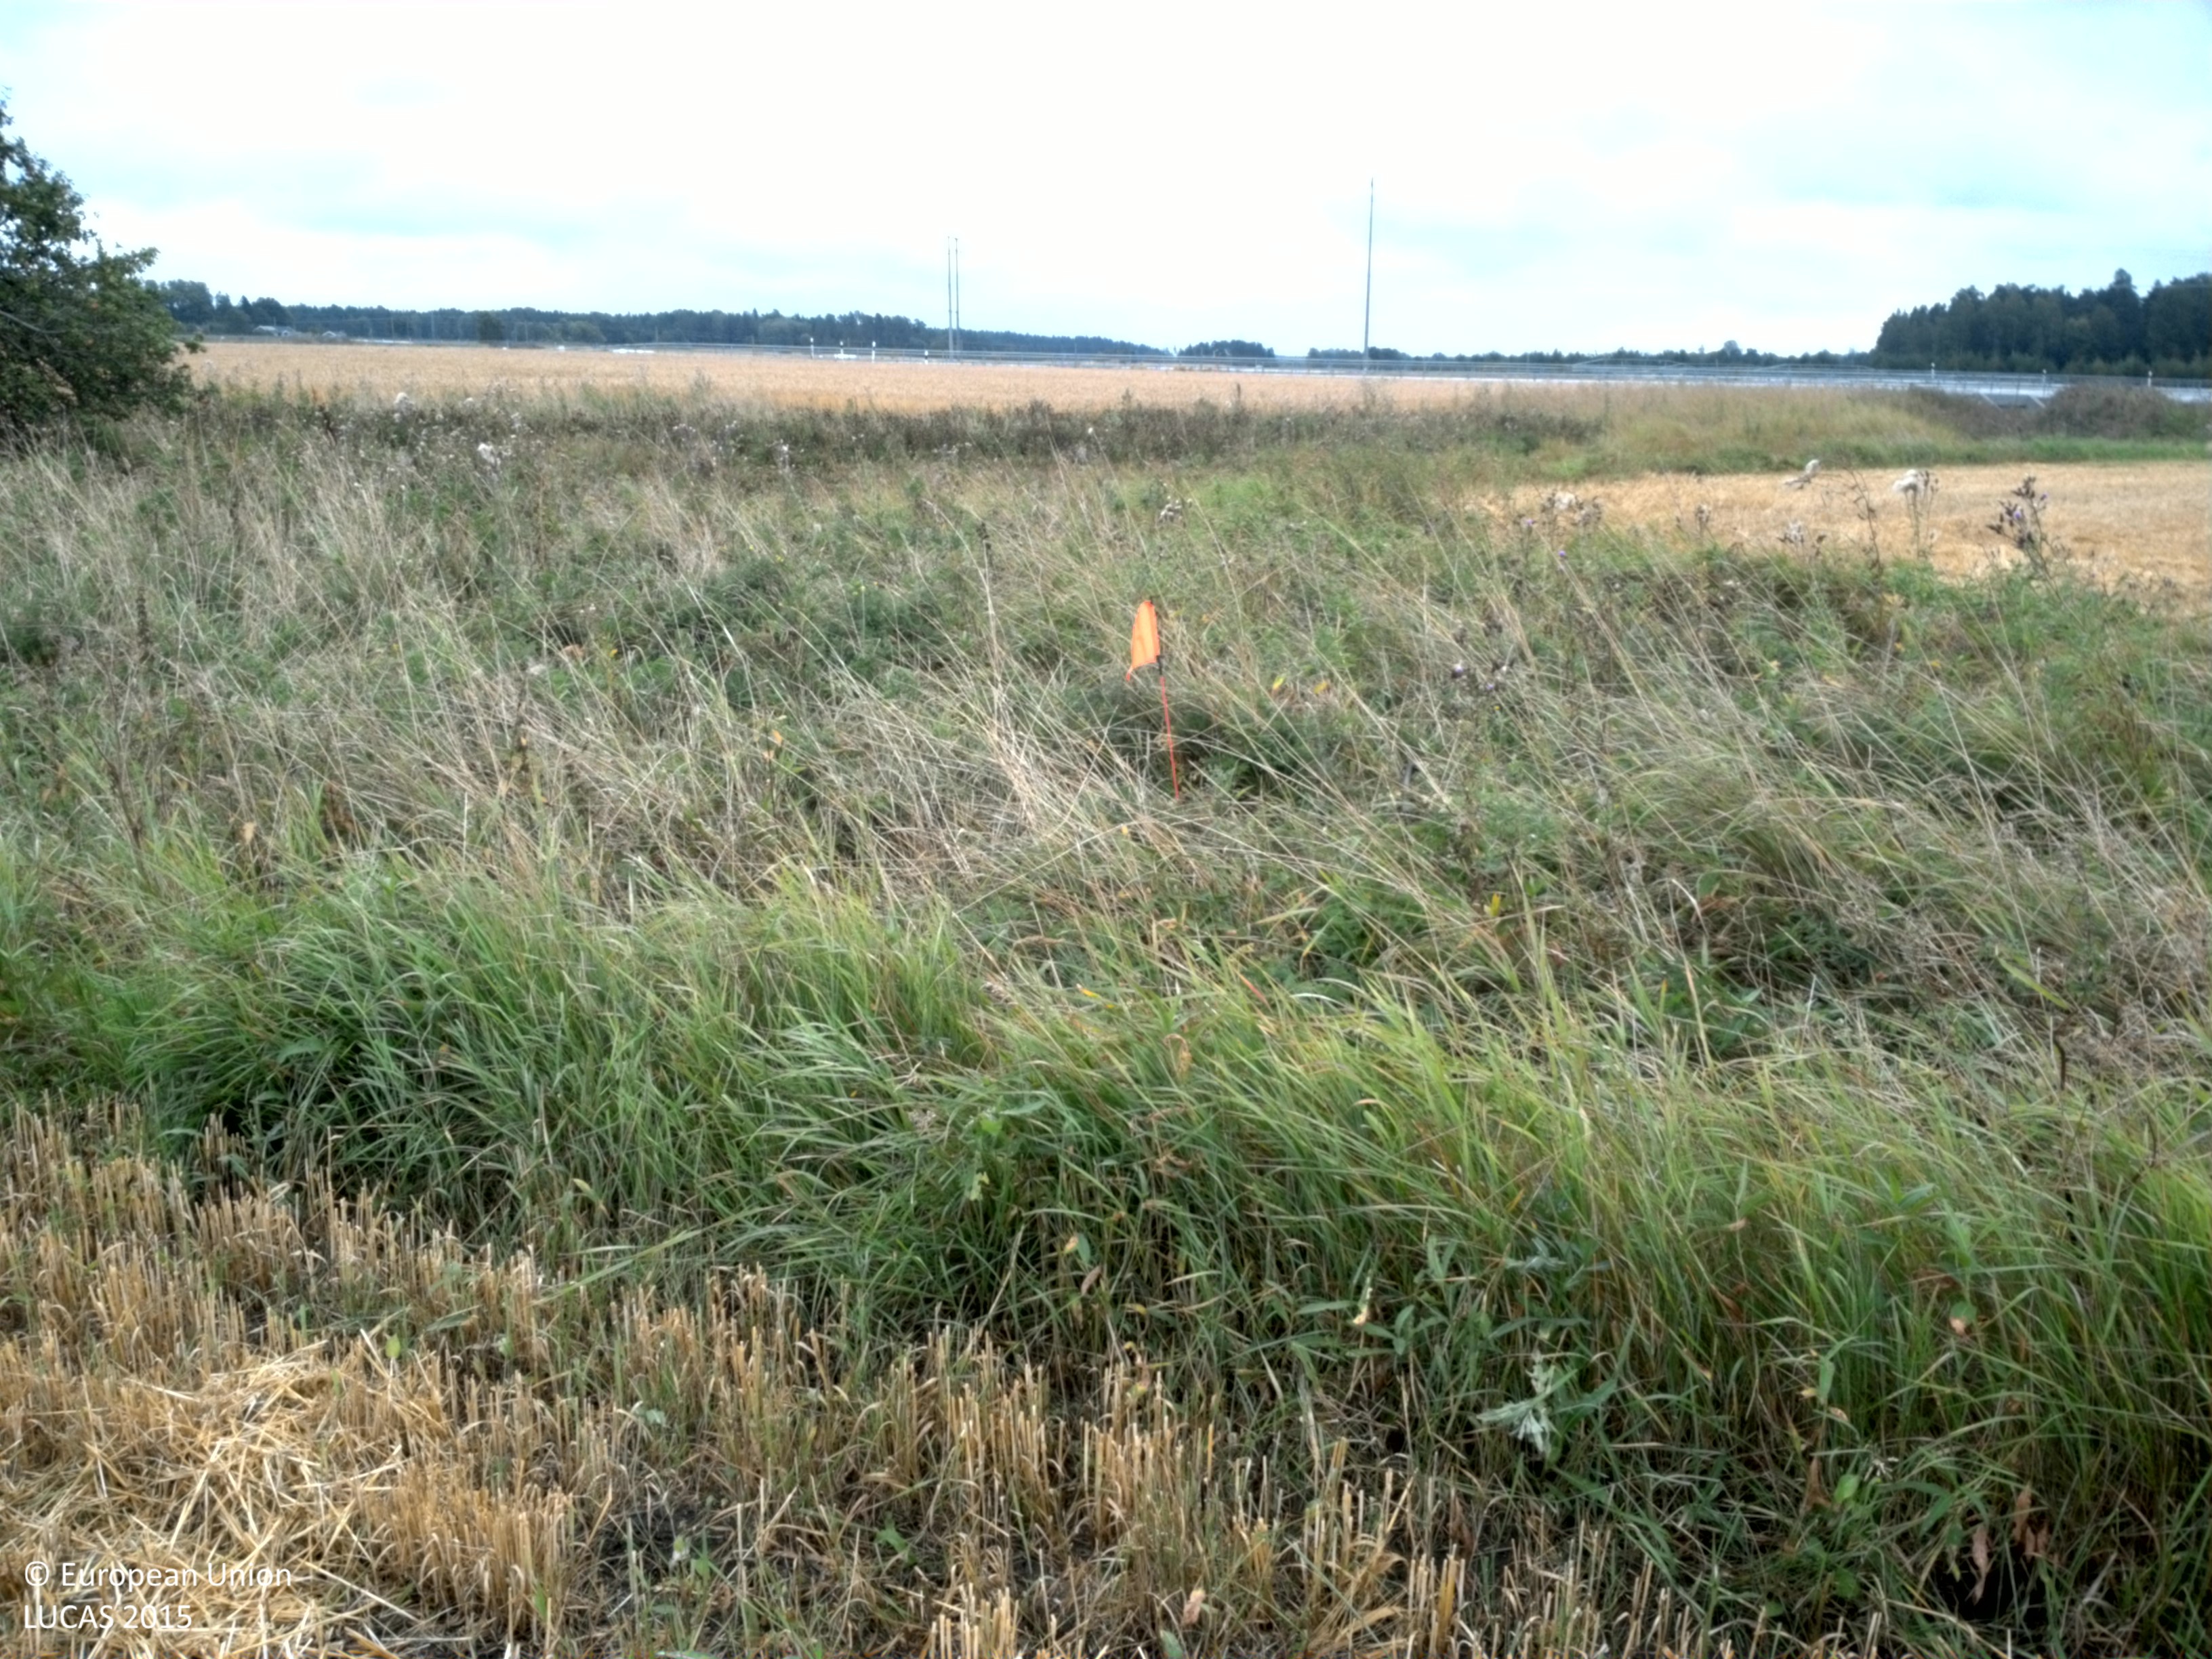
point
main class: Grassland
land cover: Grassland without tree/shrub cover
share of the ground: > 75 %
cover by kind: herbaceous plants 100 %
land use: Agriculture (excluding fallow land and kitchen gardens)
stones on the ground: < 10 %
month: August
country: SE
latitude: 59.9732
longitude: 17.6439
